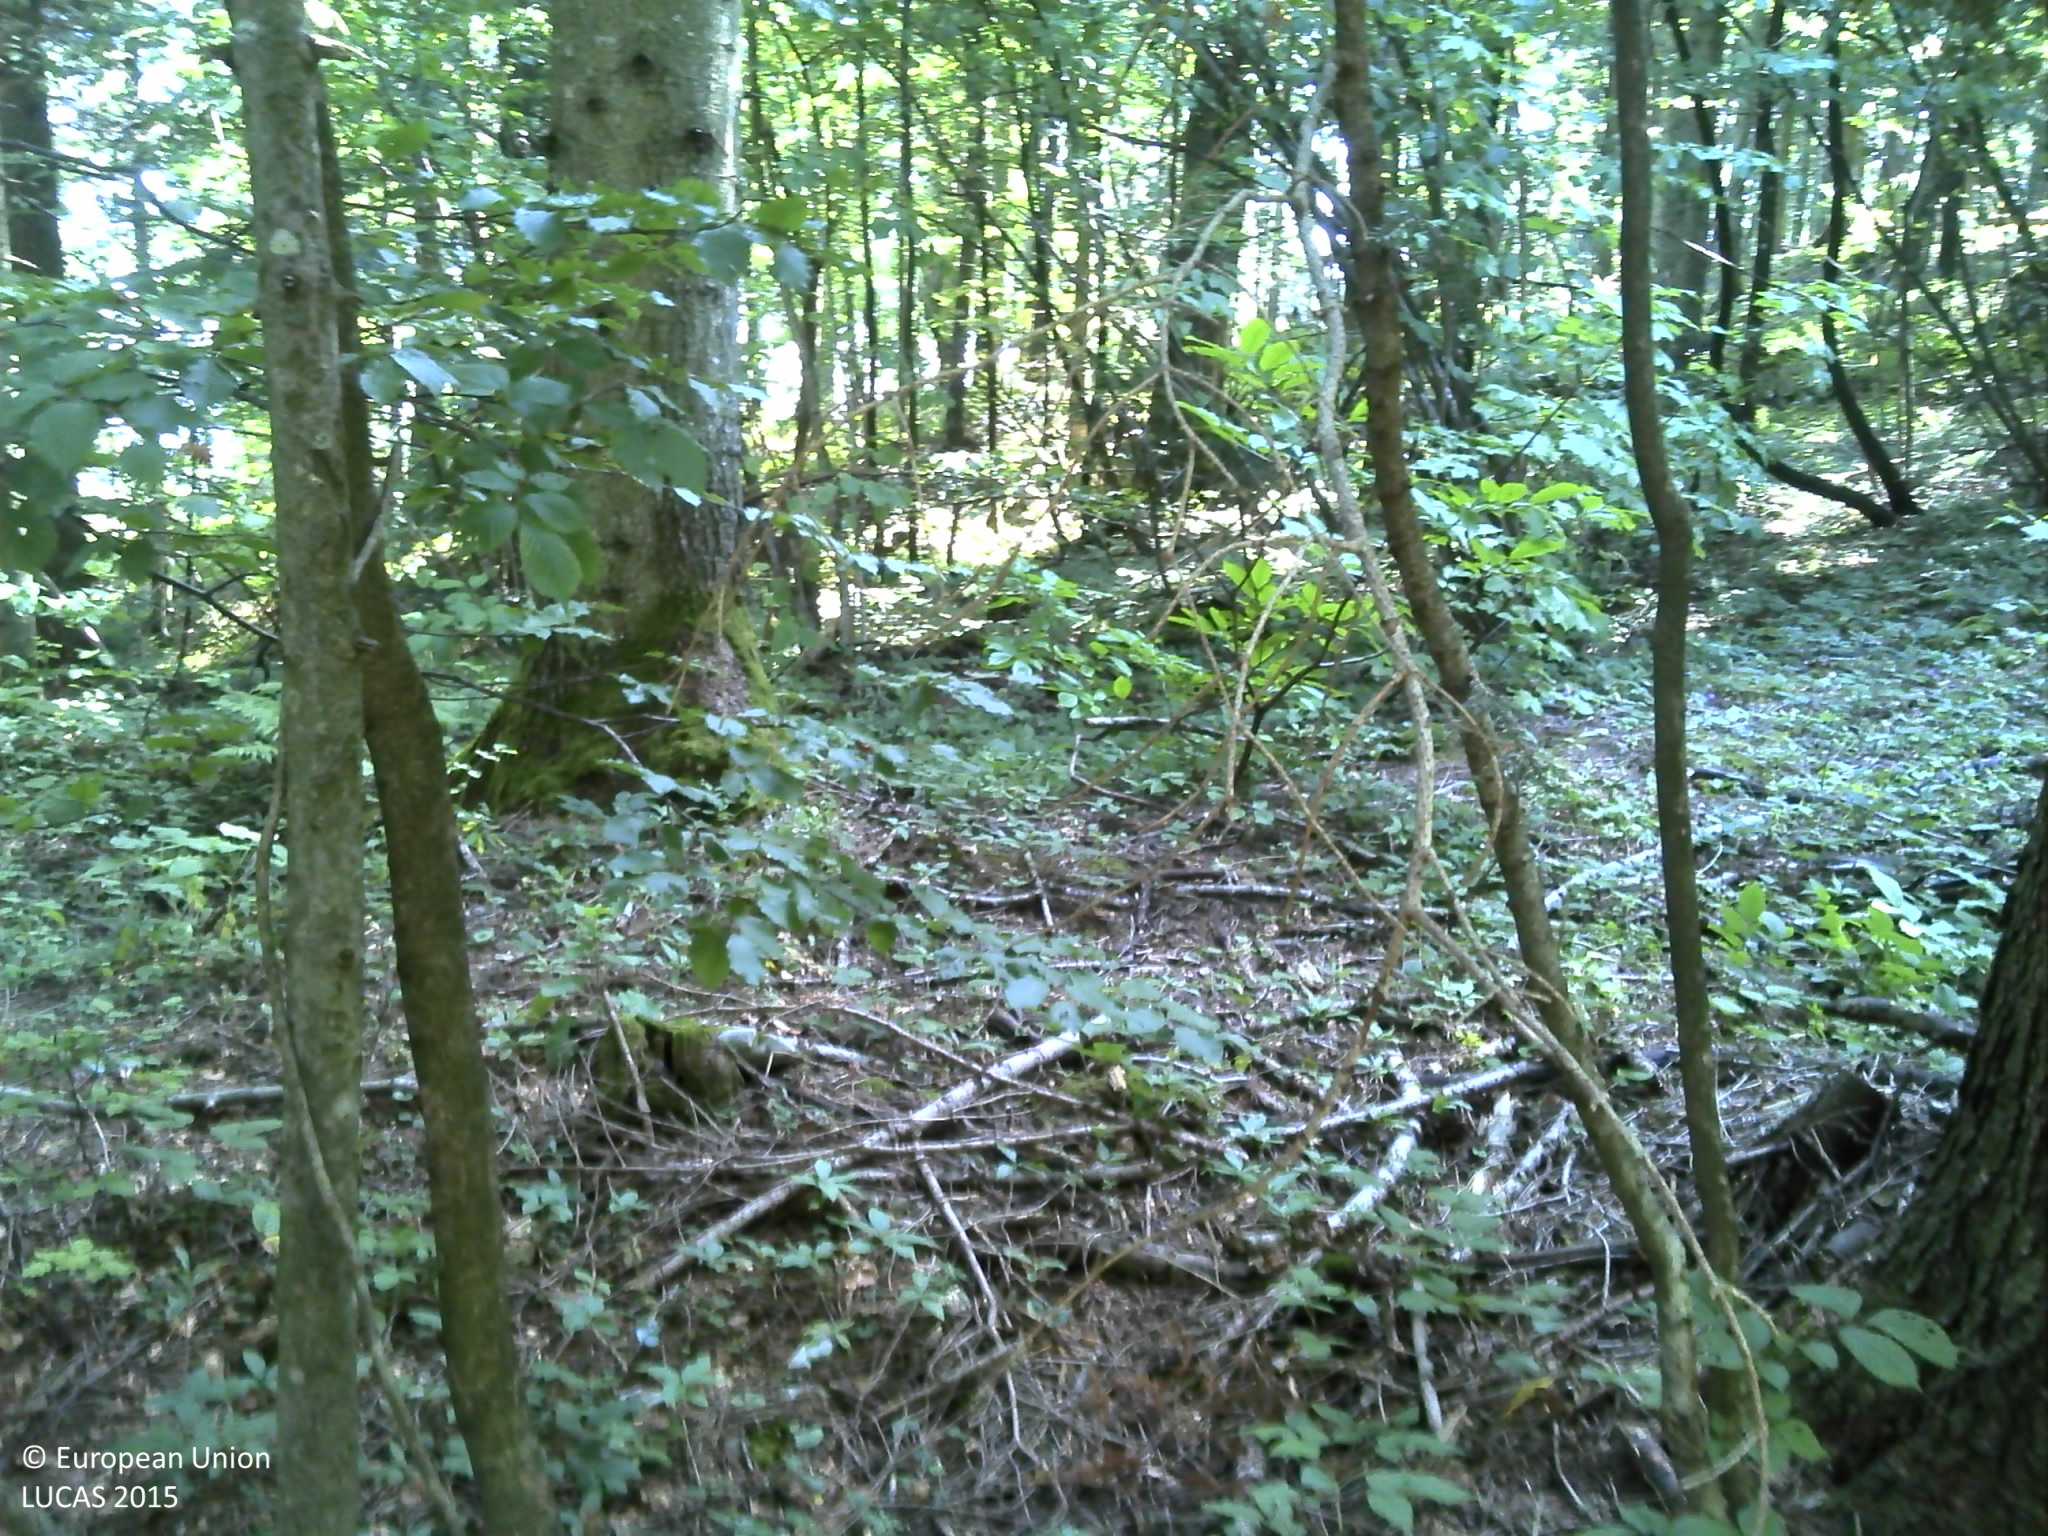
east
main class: Woodland
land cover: Pine dominated coniferous woodland
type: boreal forest
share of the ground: > 75 %
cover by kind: coniferous forest trees 100 %
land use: Forestry
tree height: > 5 m
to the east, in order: Pine dominated coniferous woodland
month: August
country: HR
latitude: 45.1956
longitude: 15.2013
